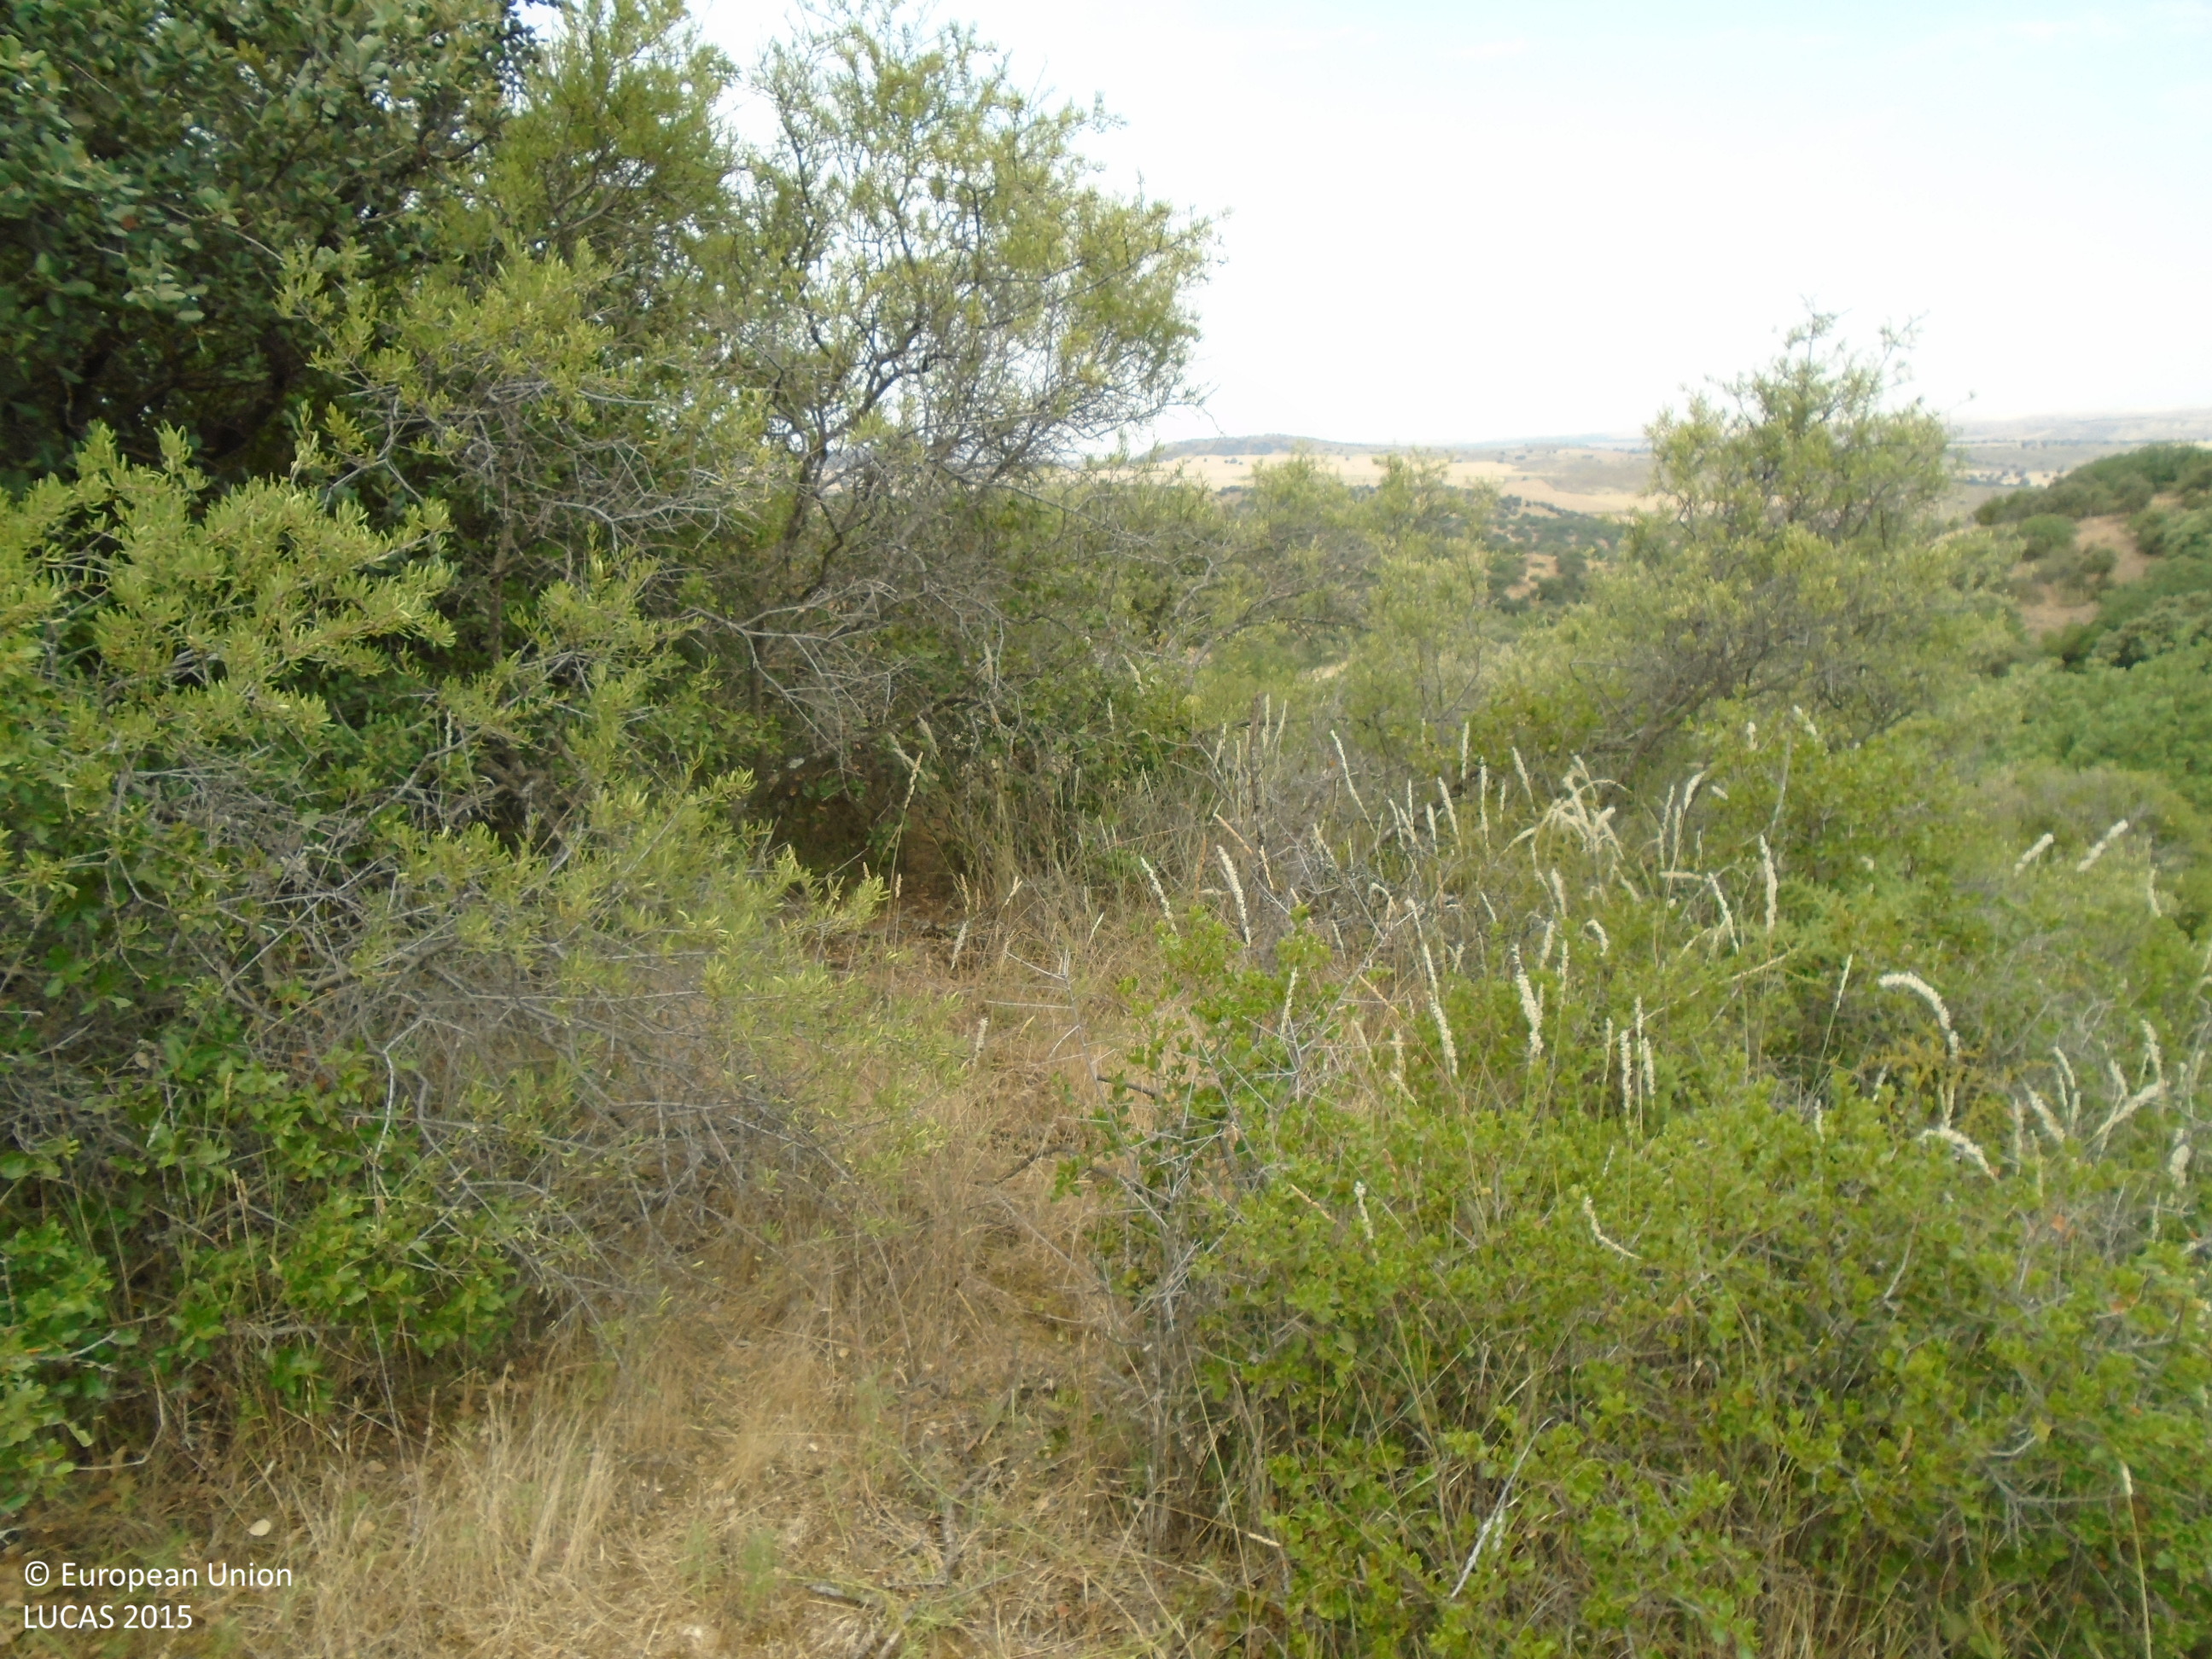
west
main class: Shrubland
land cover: Shrubland without tree cover
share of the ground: > 75 %
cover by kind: shrubs 95 %, herbaceous plants 5 %
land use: Other primary production
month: June
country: ES
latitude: 39.8180
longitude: -4.1833
